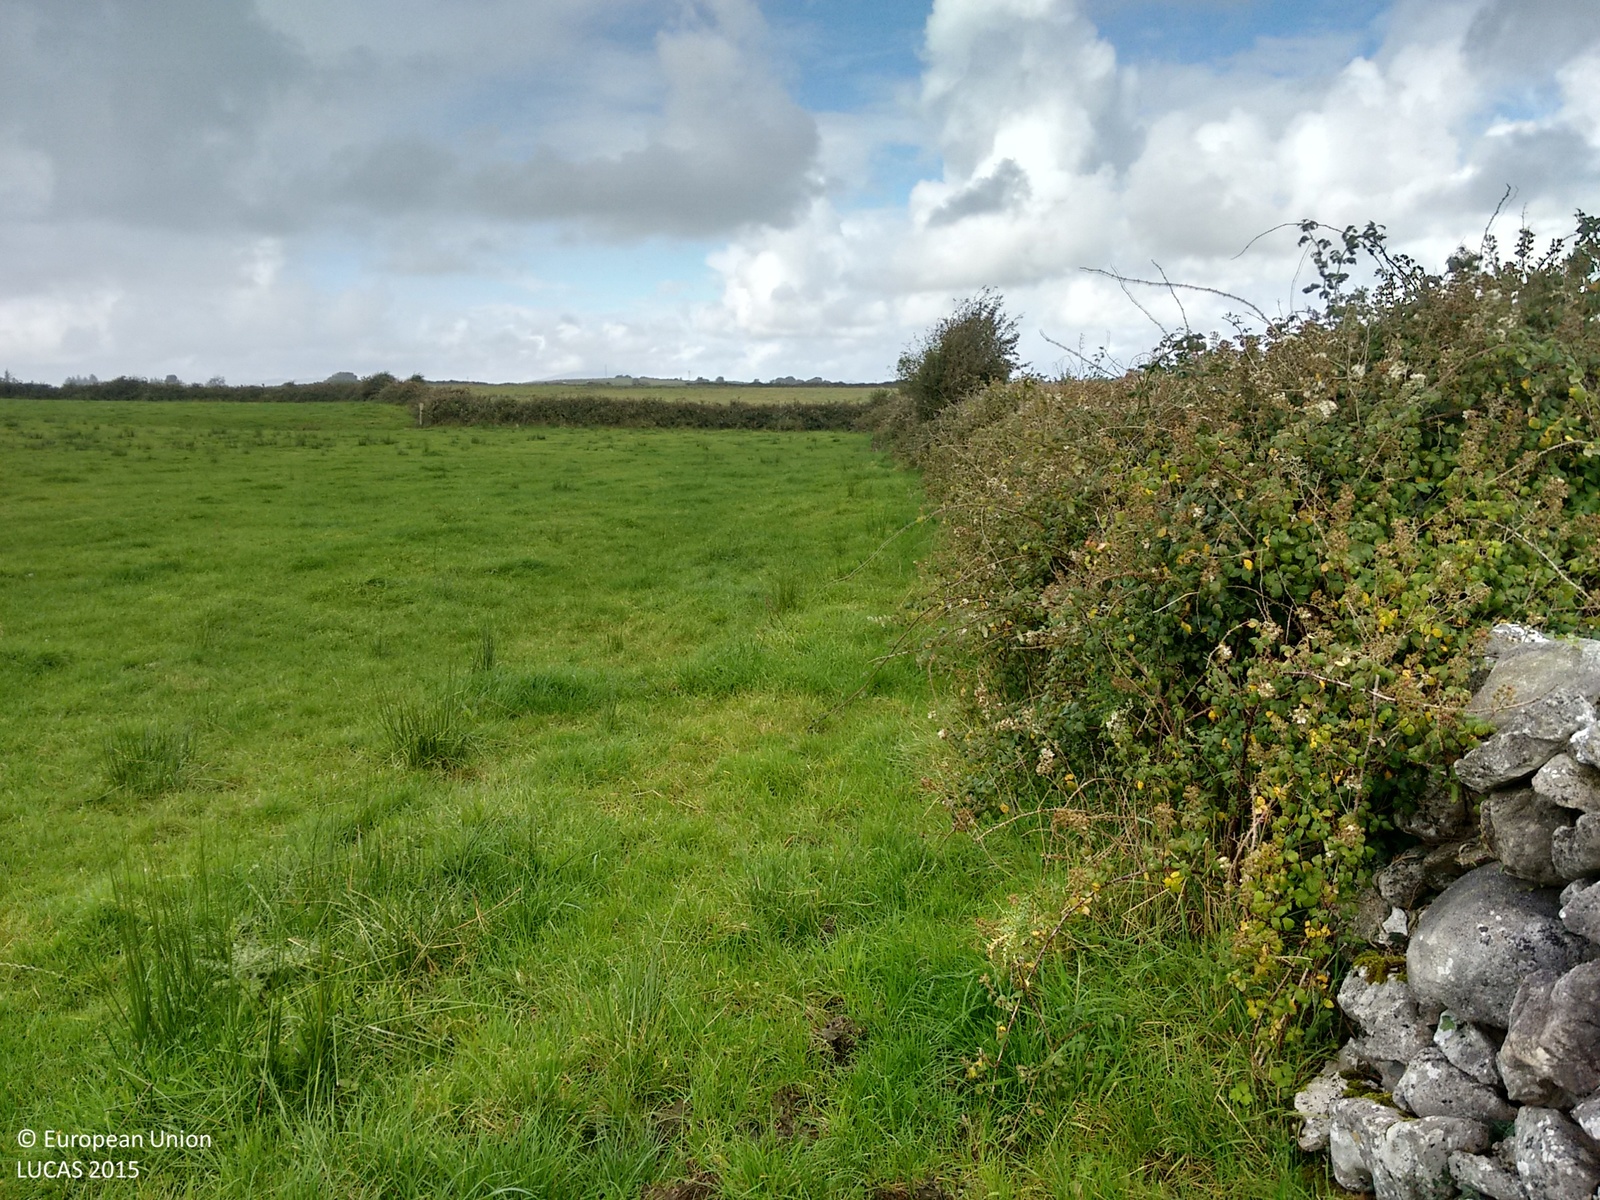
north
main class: Grassland
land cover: Grassland without tree/shrub cover
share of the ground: > 75 %
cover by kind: herbaceous plants 100 %
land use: Agriculture (excluding fallow land and kitchen gardens)
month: September
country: IE
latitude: 53.7698
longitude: -9.2001
